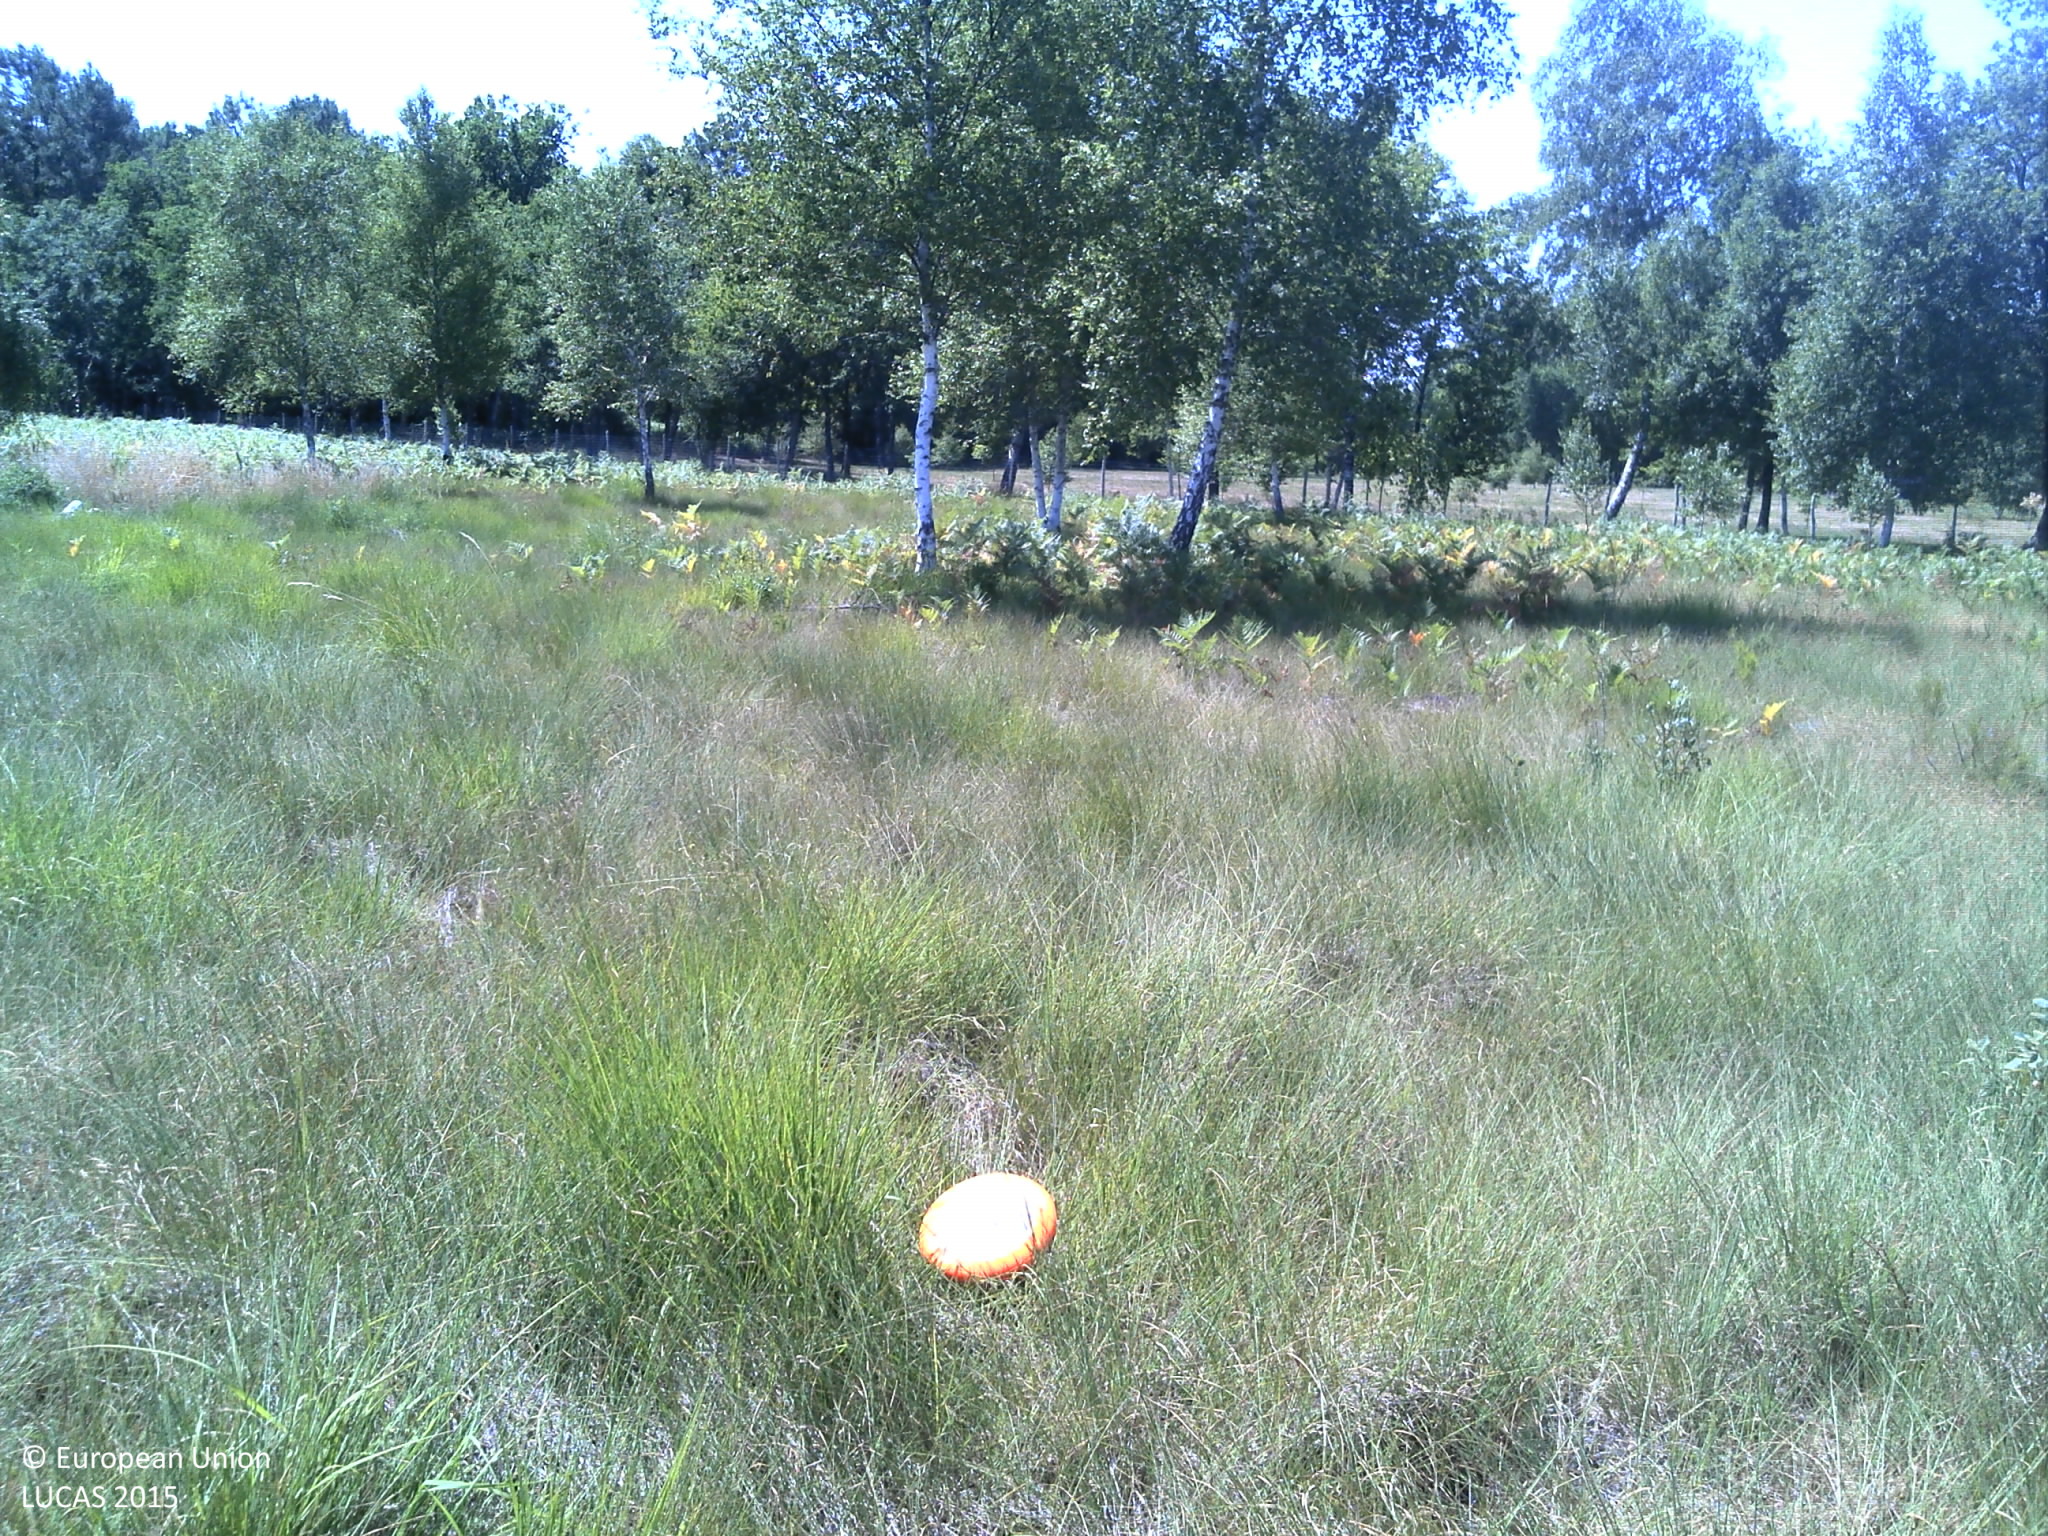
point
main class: Grassland
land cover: Grassland with sparse tree/shrub cover
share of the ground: > 75 %
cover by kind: herbaceous plants 80 %, shrubs 10 %, broadleaved forest trees 5 %, lichens and mosses 5 %
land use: Agriculture (excluding fallow land and kitchen gardens)
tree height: < 5 m
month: July
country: FR
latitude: 44.5662
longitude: -0.6318
